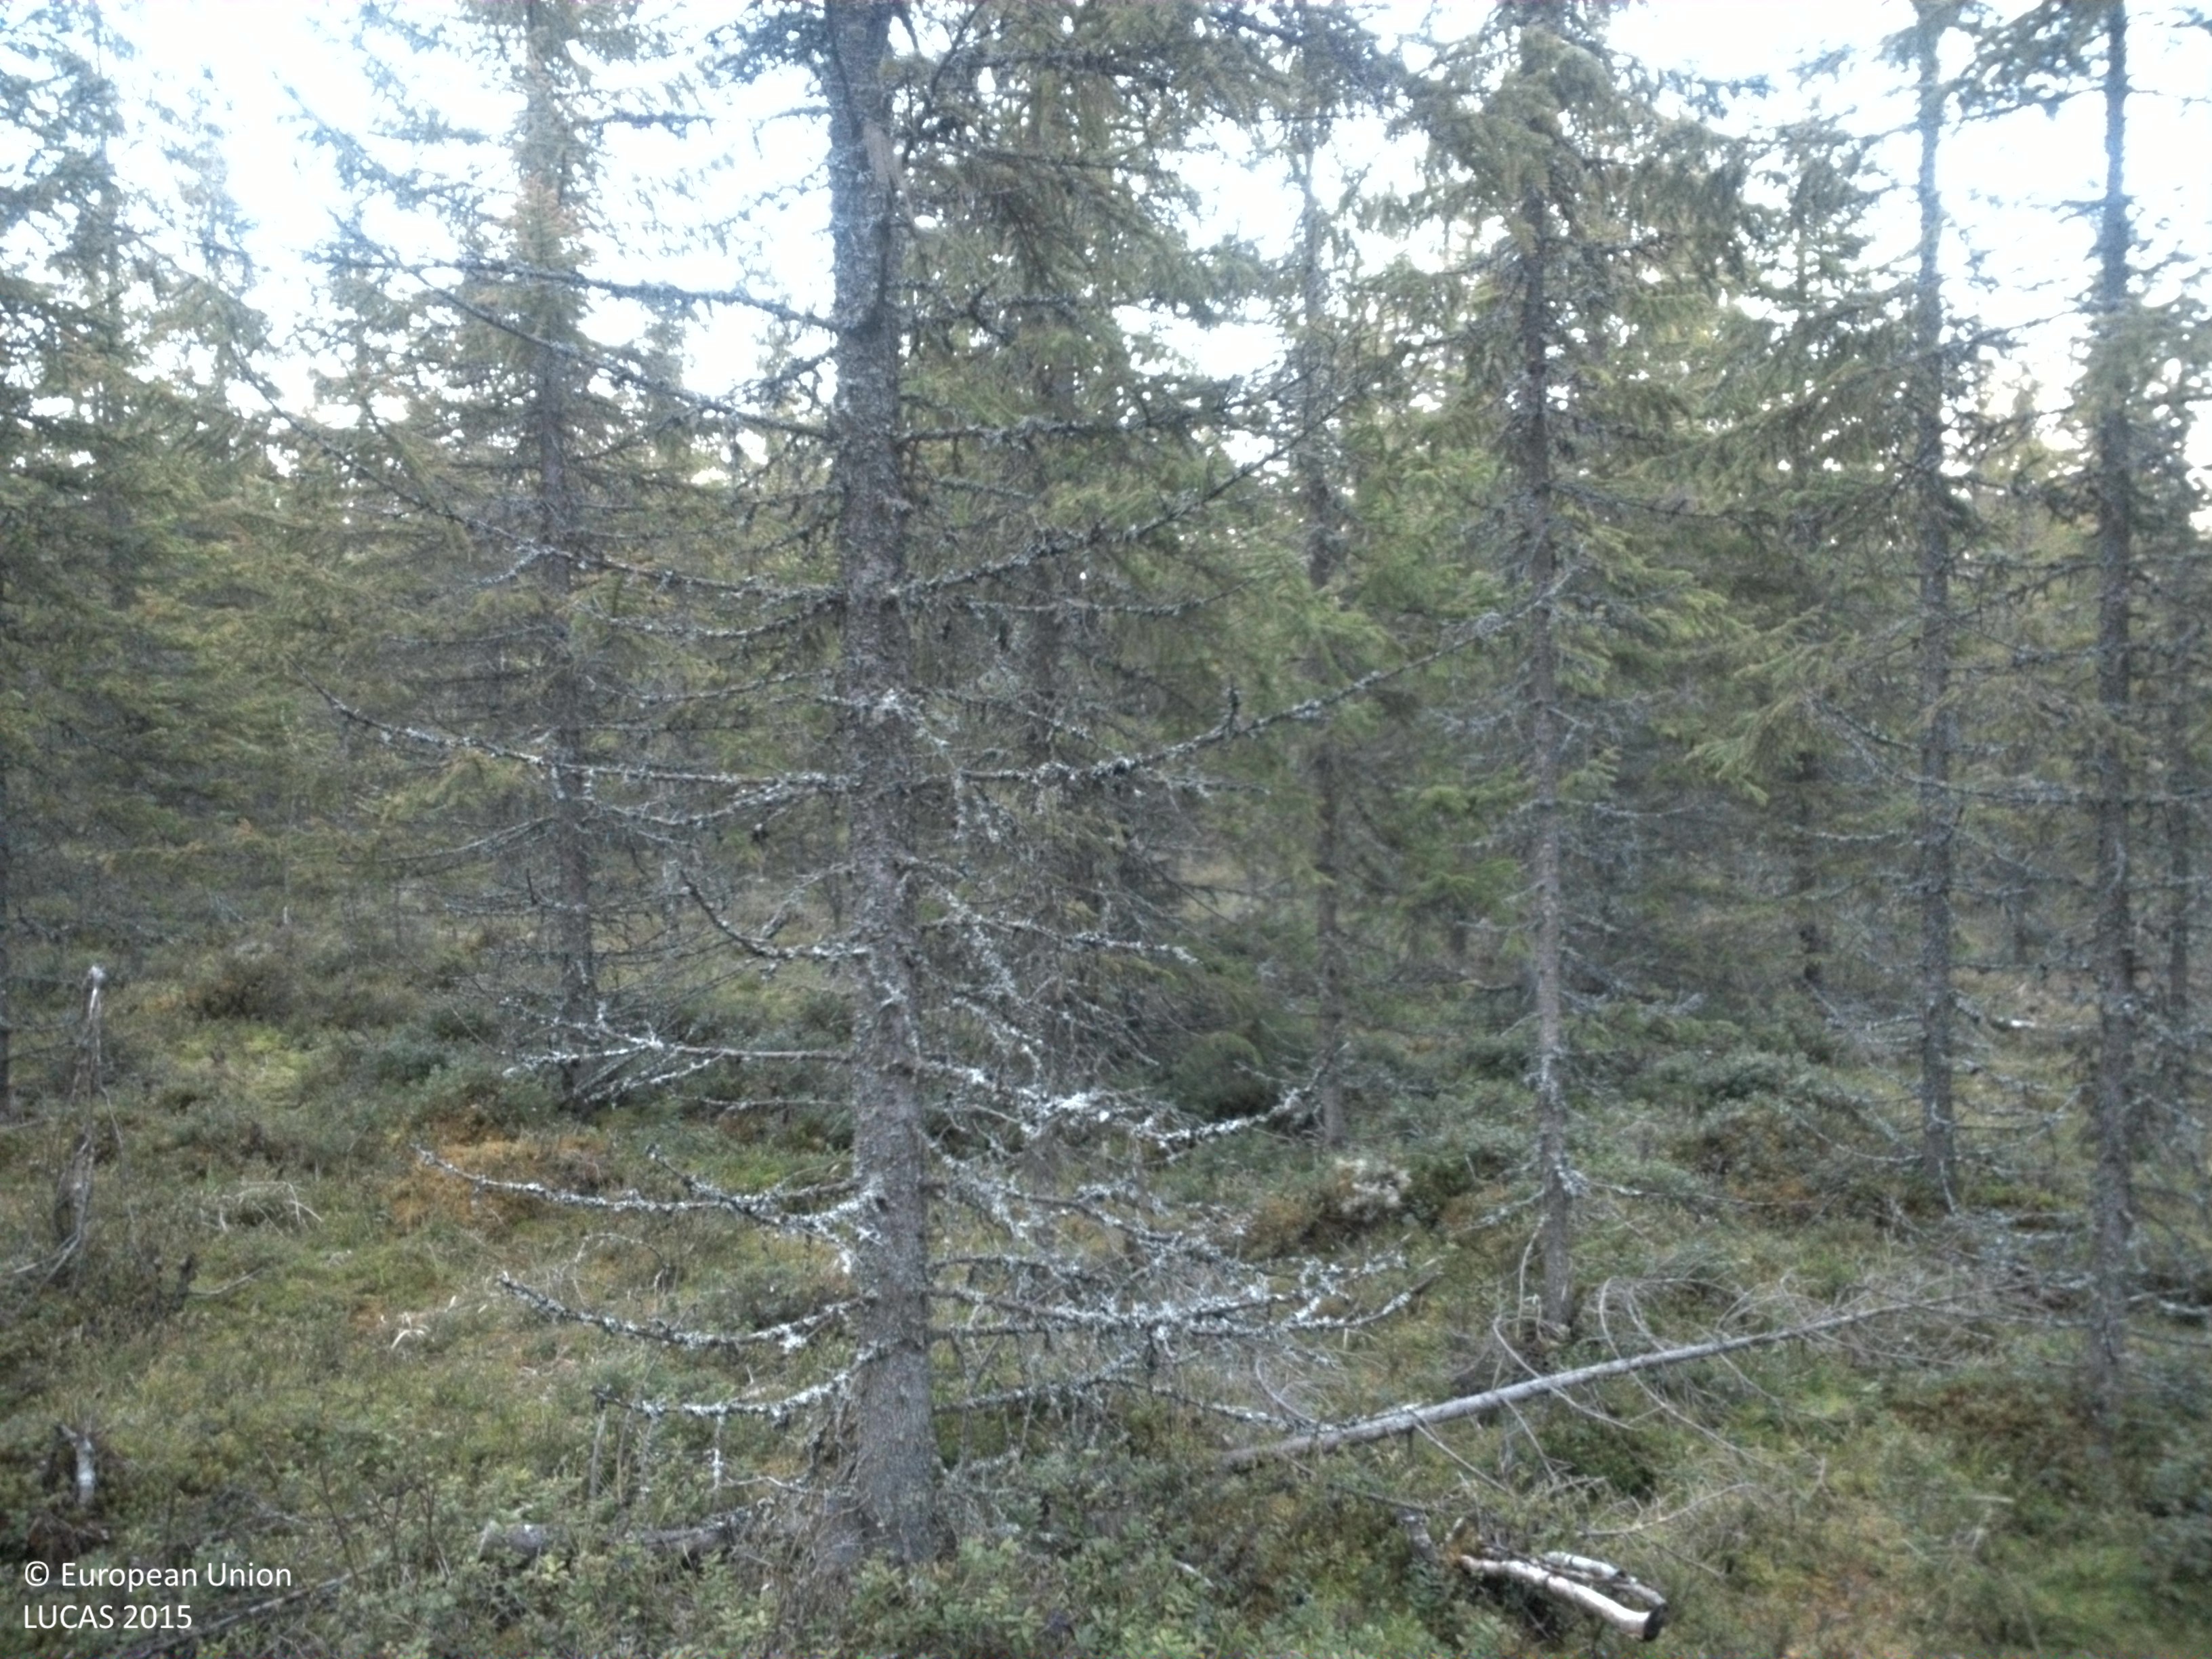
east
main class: Woodland
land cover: Spruce dominated coniferous woodland
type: boreal forest
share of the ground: > 75 %
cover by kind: coniferous forest trees 80 %, shrubs 20 %
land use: Forestry
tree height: > 5 m
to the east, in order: Spruce dominated coniferous woodland; Ditches and canals; Pine dominated mixed woodland; Broadleaved woodland
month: May
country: SE
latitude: 60.9346
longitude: 12.4089
